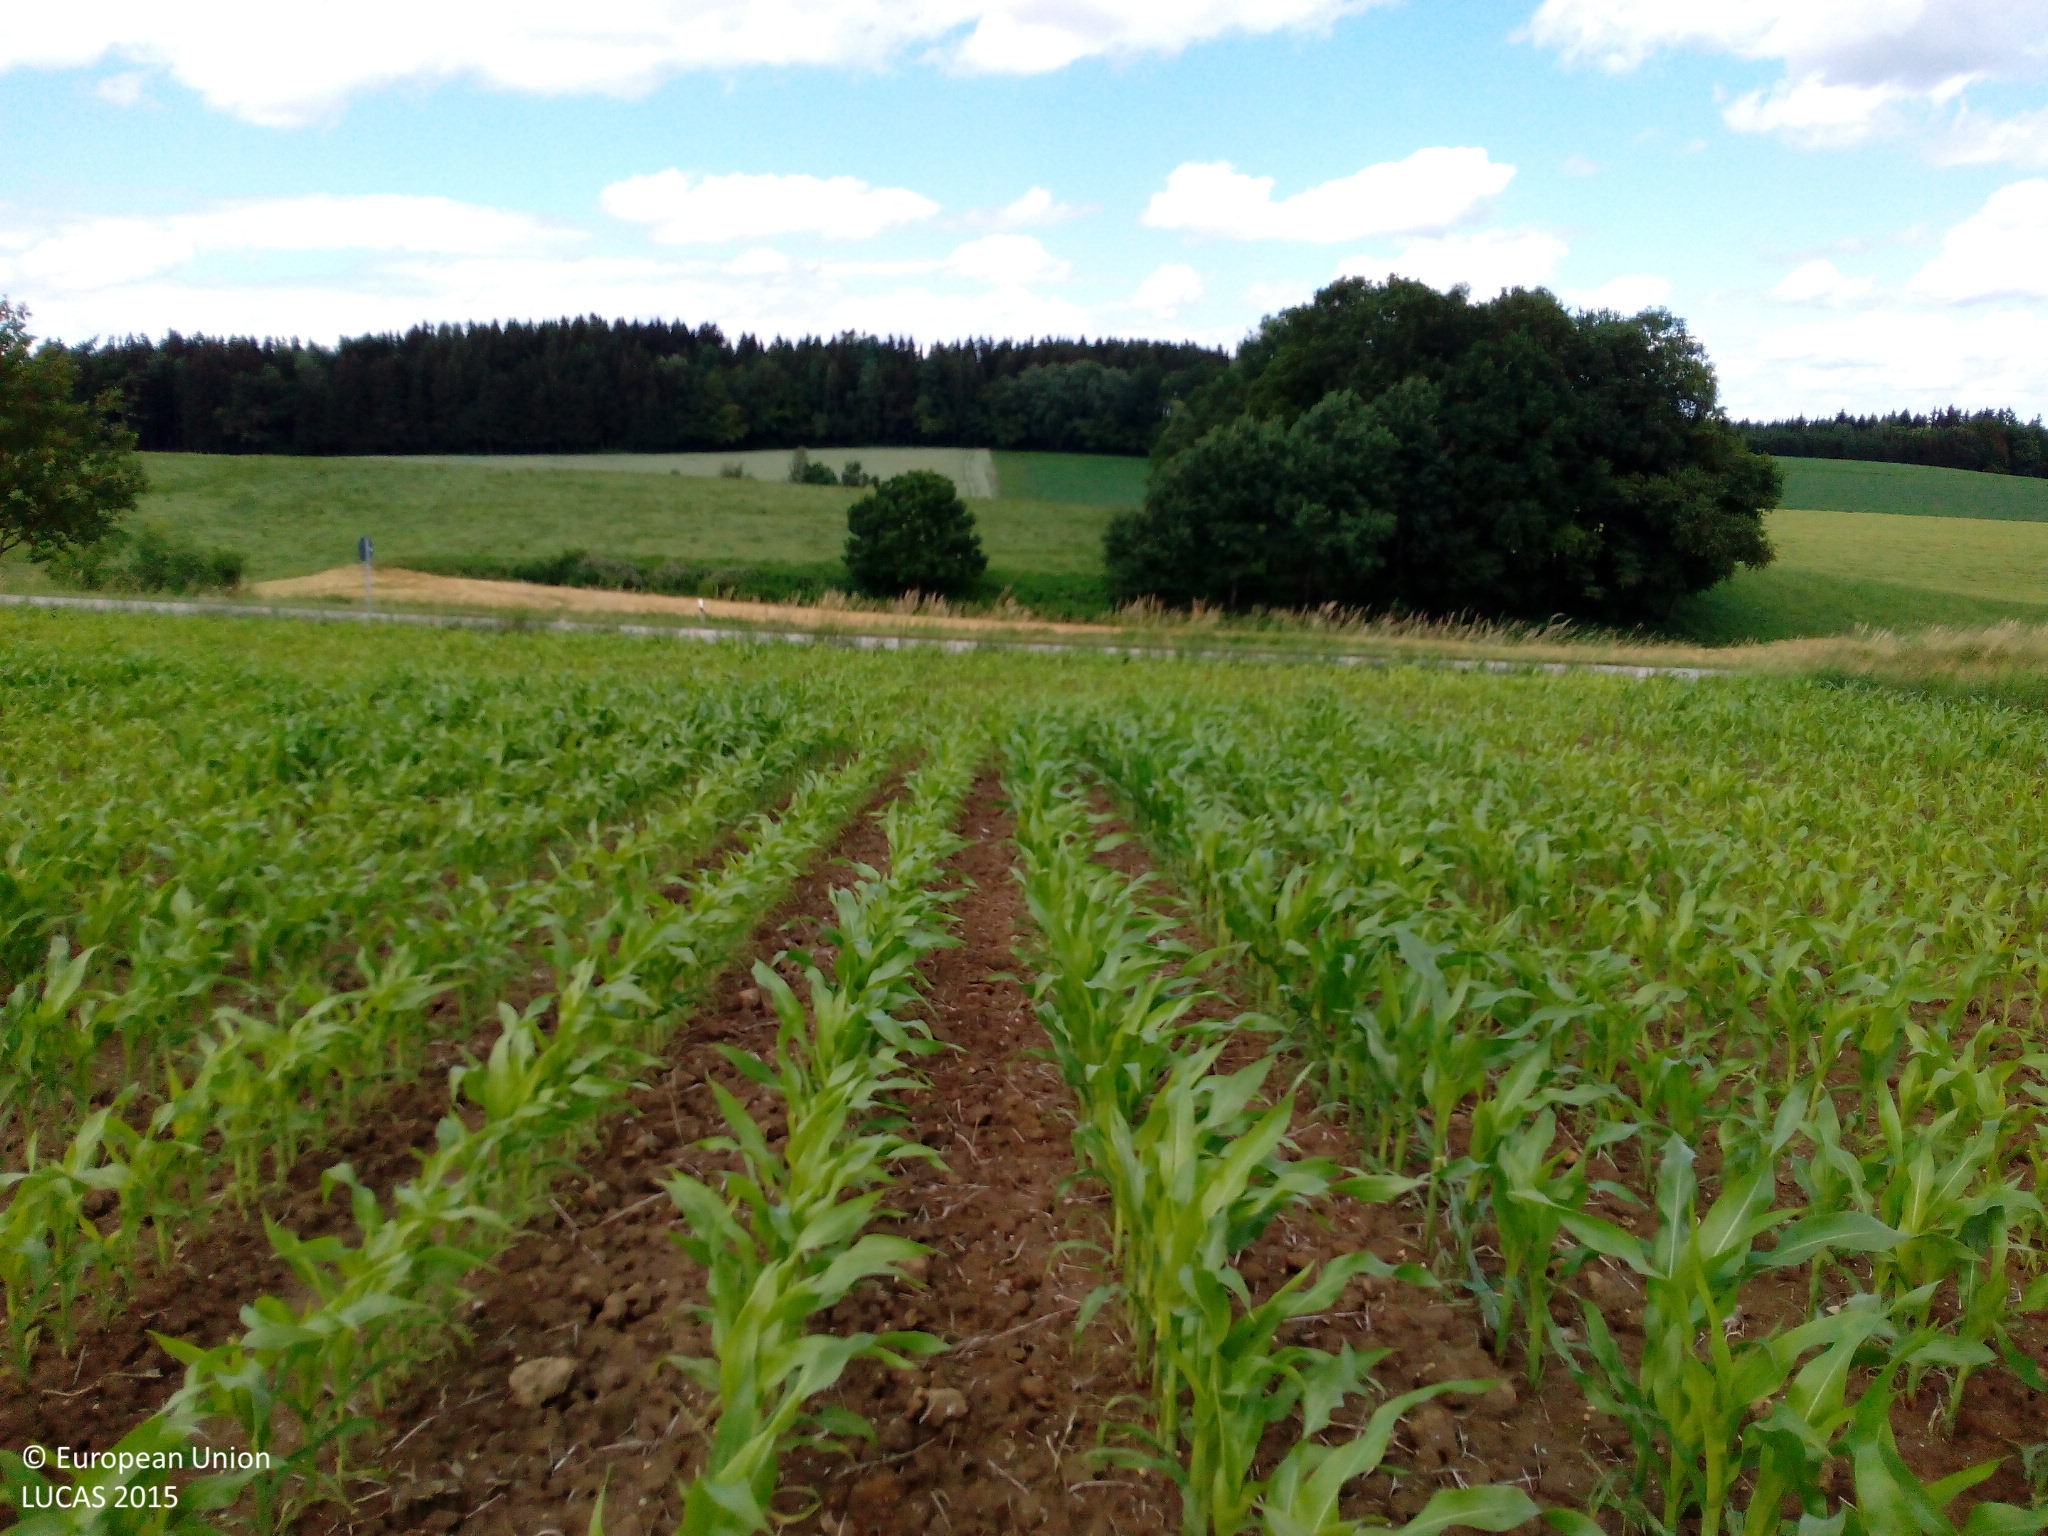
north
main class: Cropland
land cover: Maize
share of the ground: 25 - 50 %
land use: Agriculture (excluding fallow land and kitchen gardens)
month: June
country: DE
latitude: 48.2889
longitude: 12.3307
